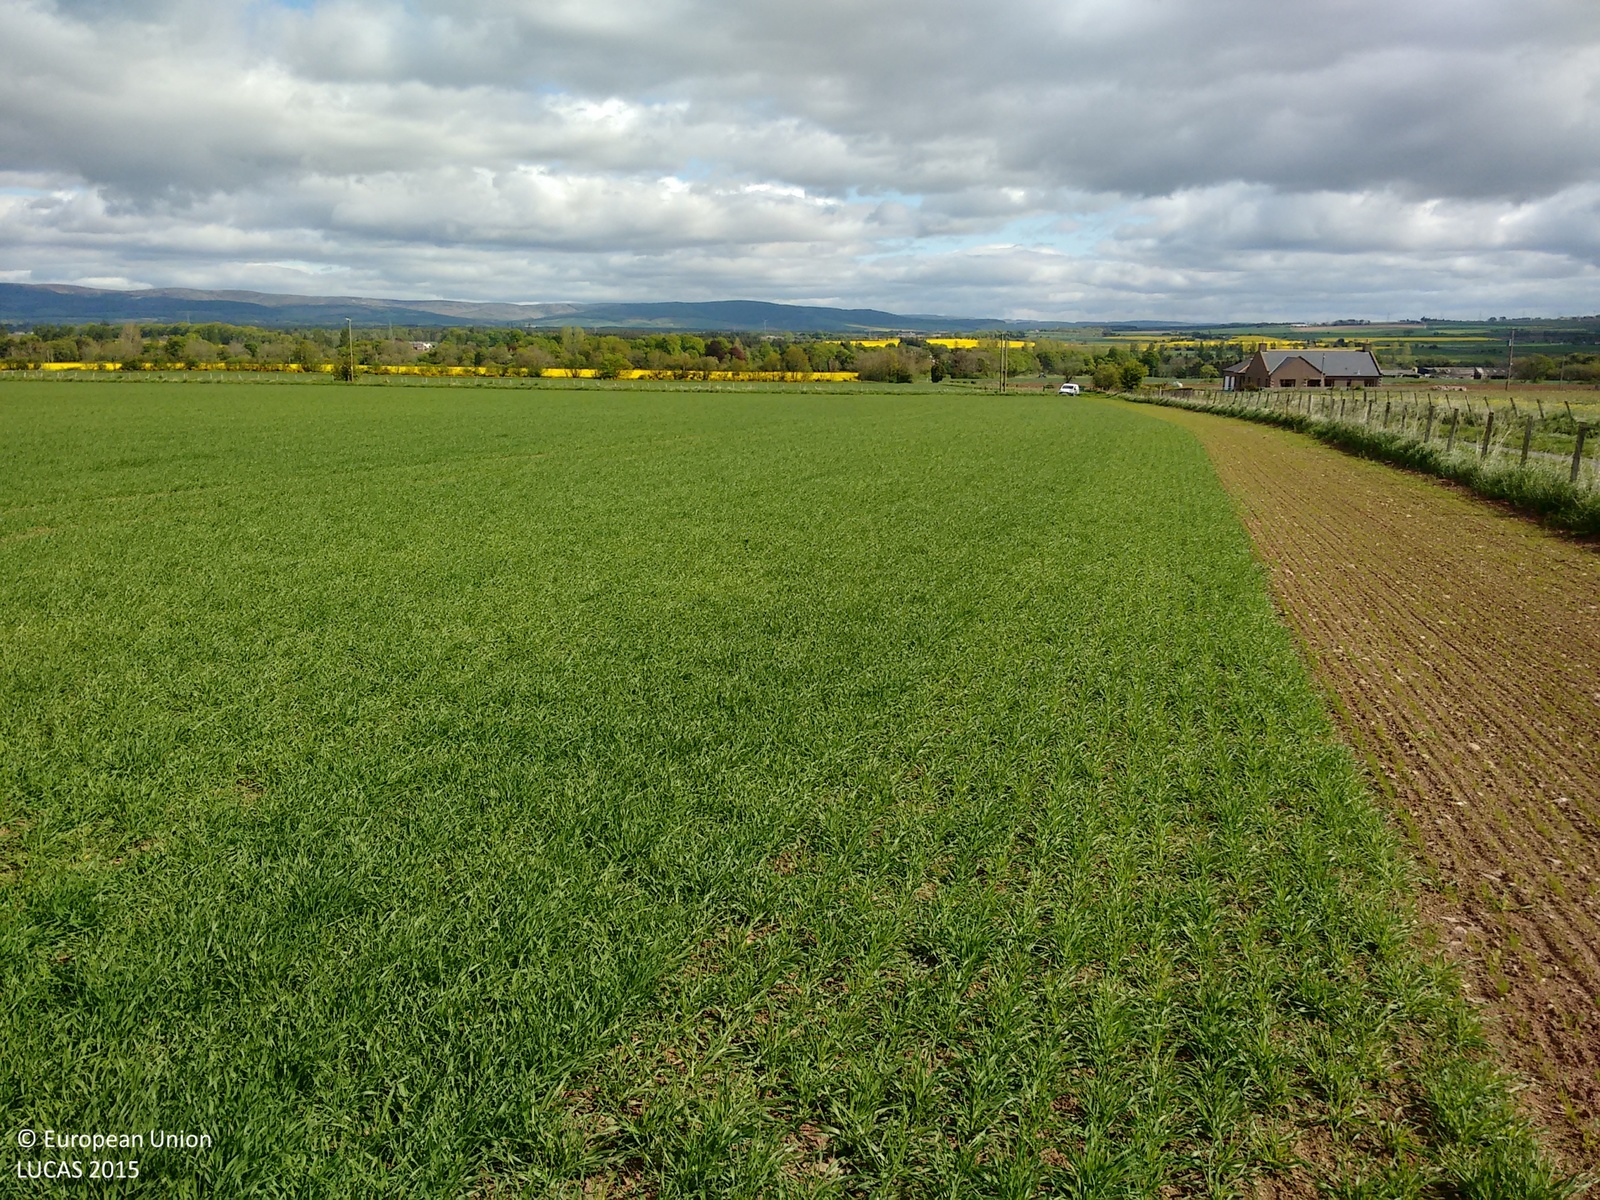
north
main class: Cropland
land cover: Barley
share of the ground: > 75 %
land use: Agriculture (excluding fallow land and kitchen gardens)
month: May
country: GB
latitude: 56.7722
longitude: -2.5416
